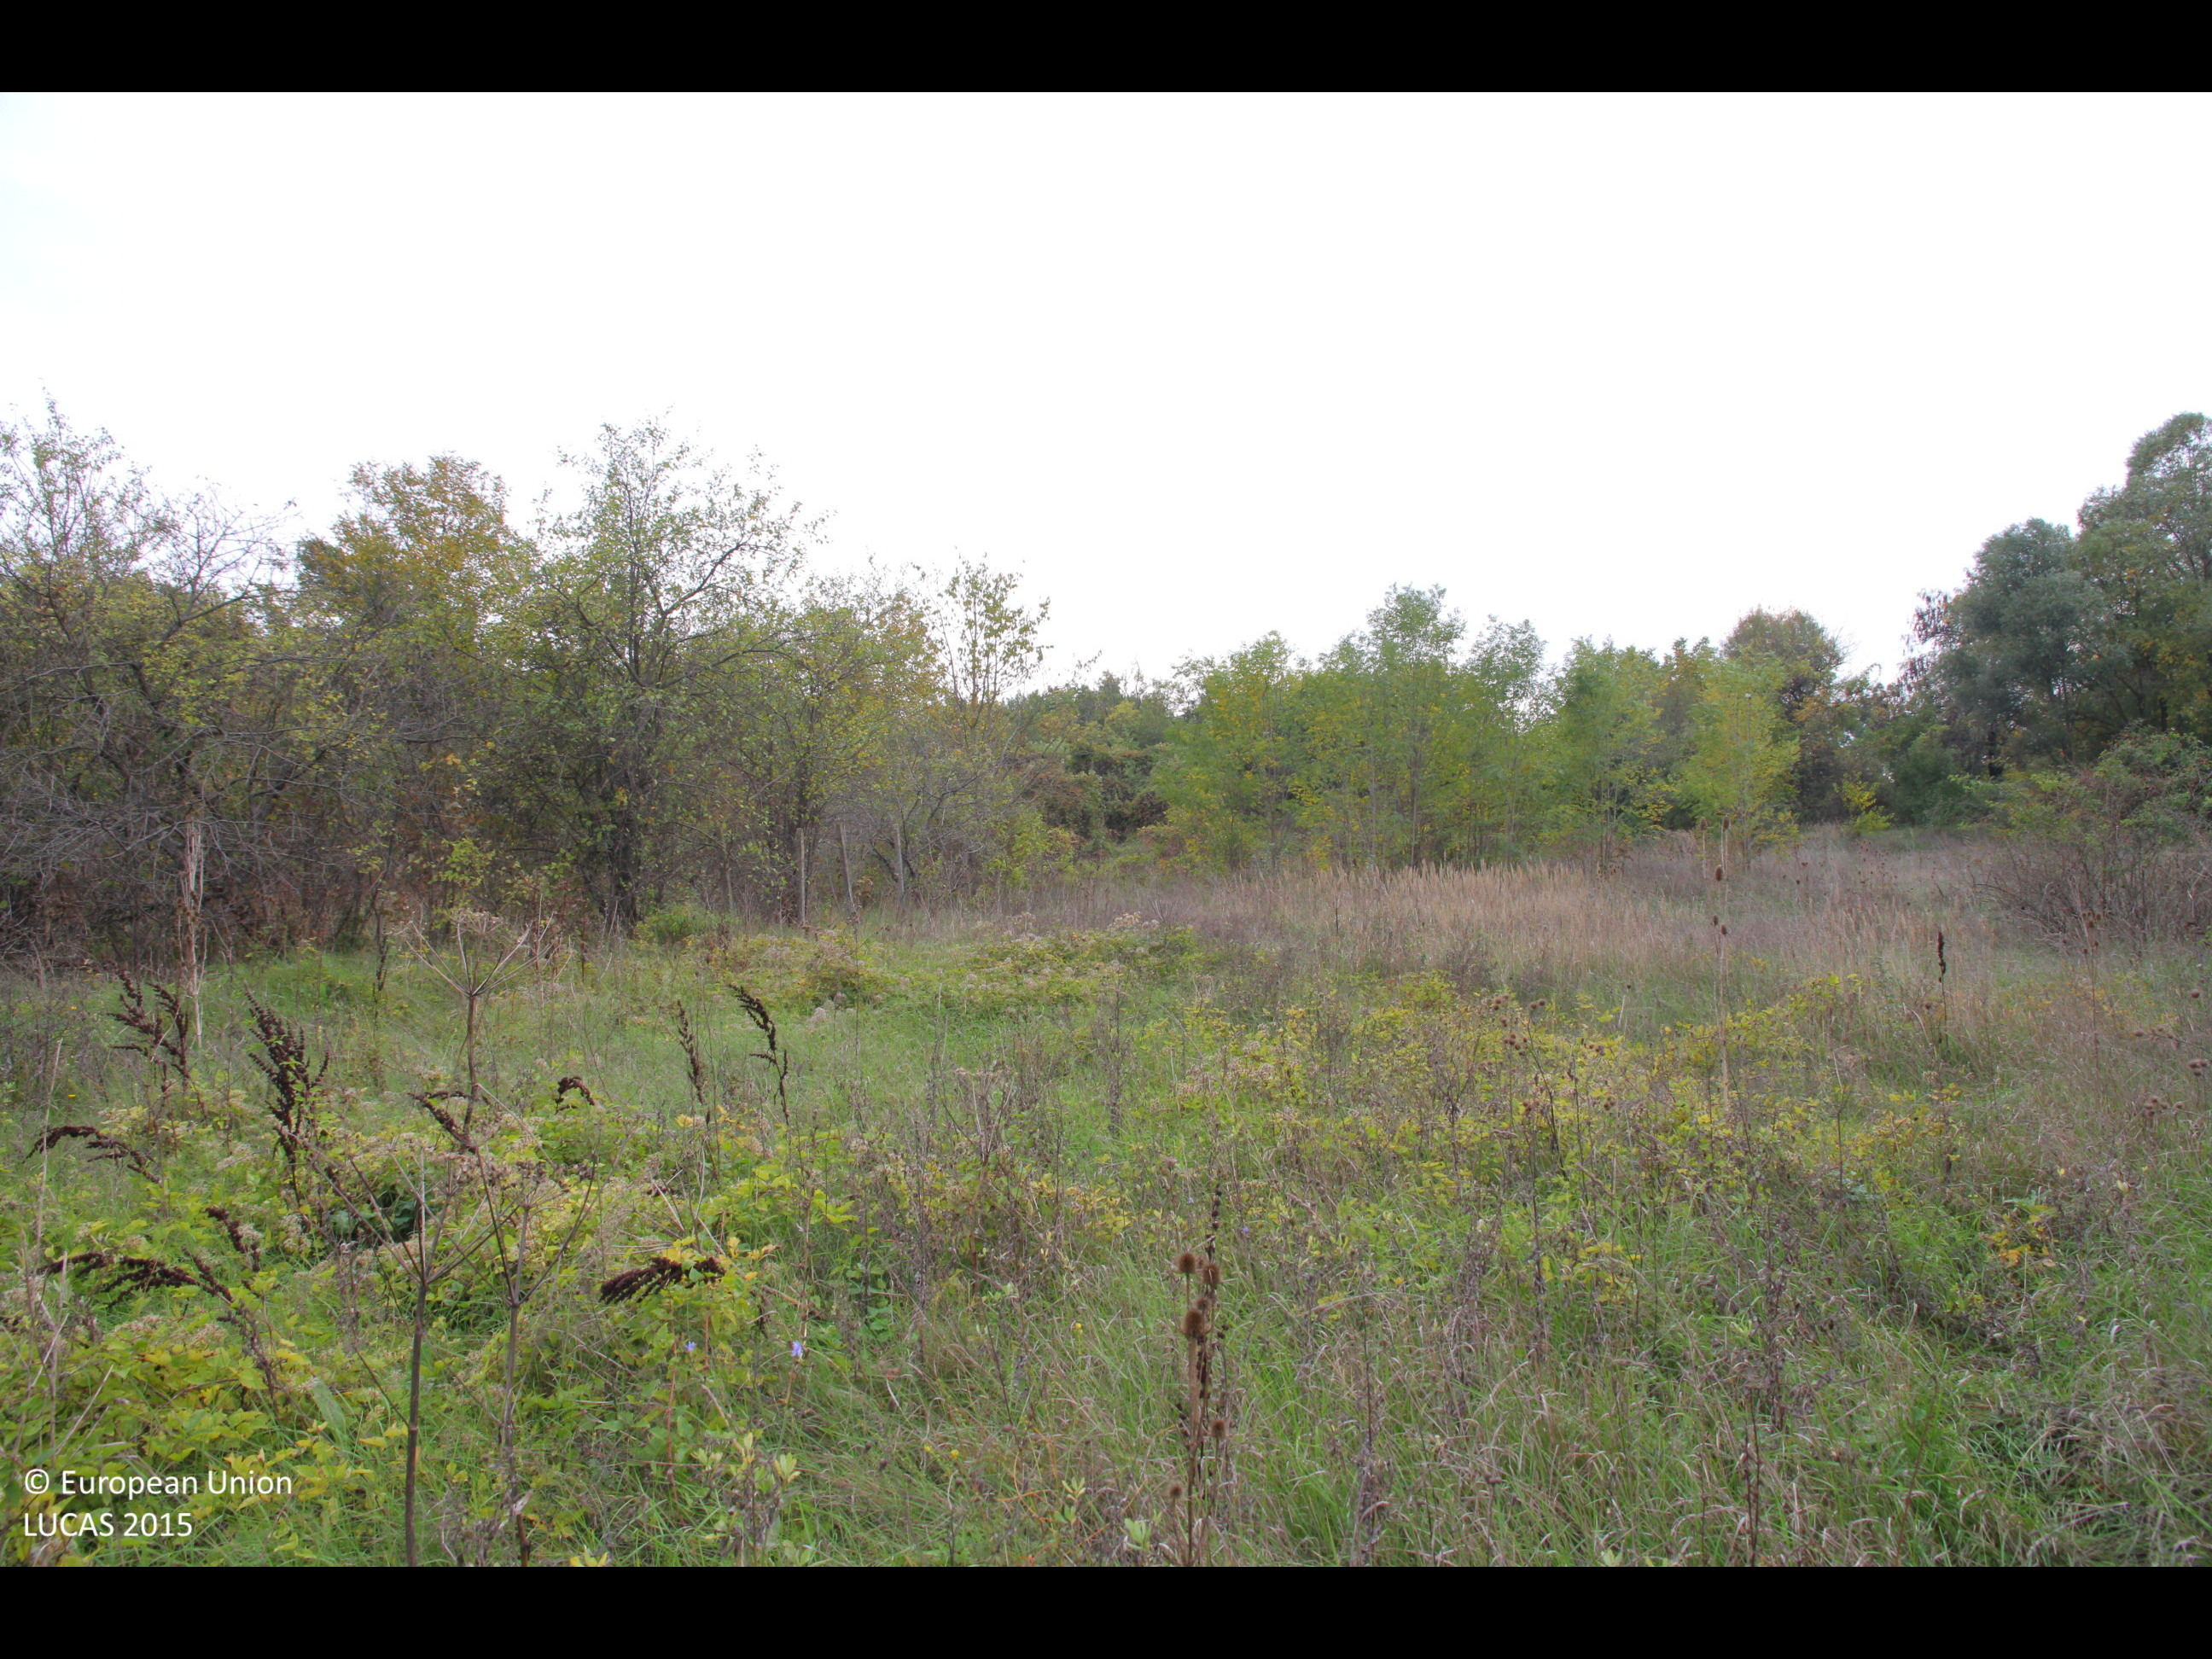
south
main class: Grassland
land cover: Grassland without tree/shrub cover
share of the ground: > 75 %
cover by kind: herbaceous plants 95 %, shrubs 5 %
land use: Semi-natural and natural areas not in use
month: October
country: BG
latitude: 43.2912
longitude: 26.9623
